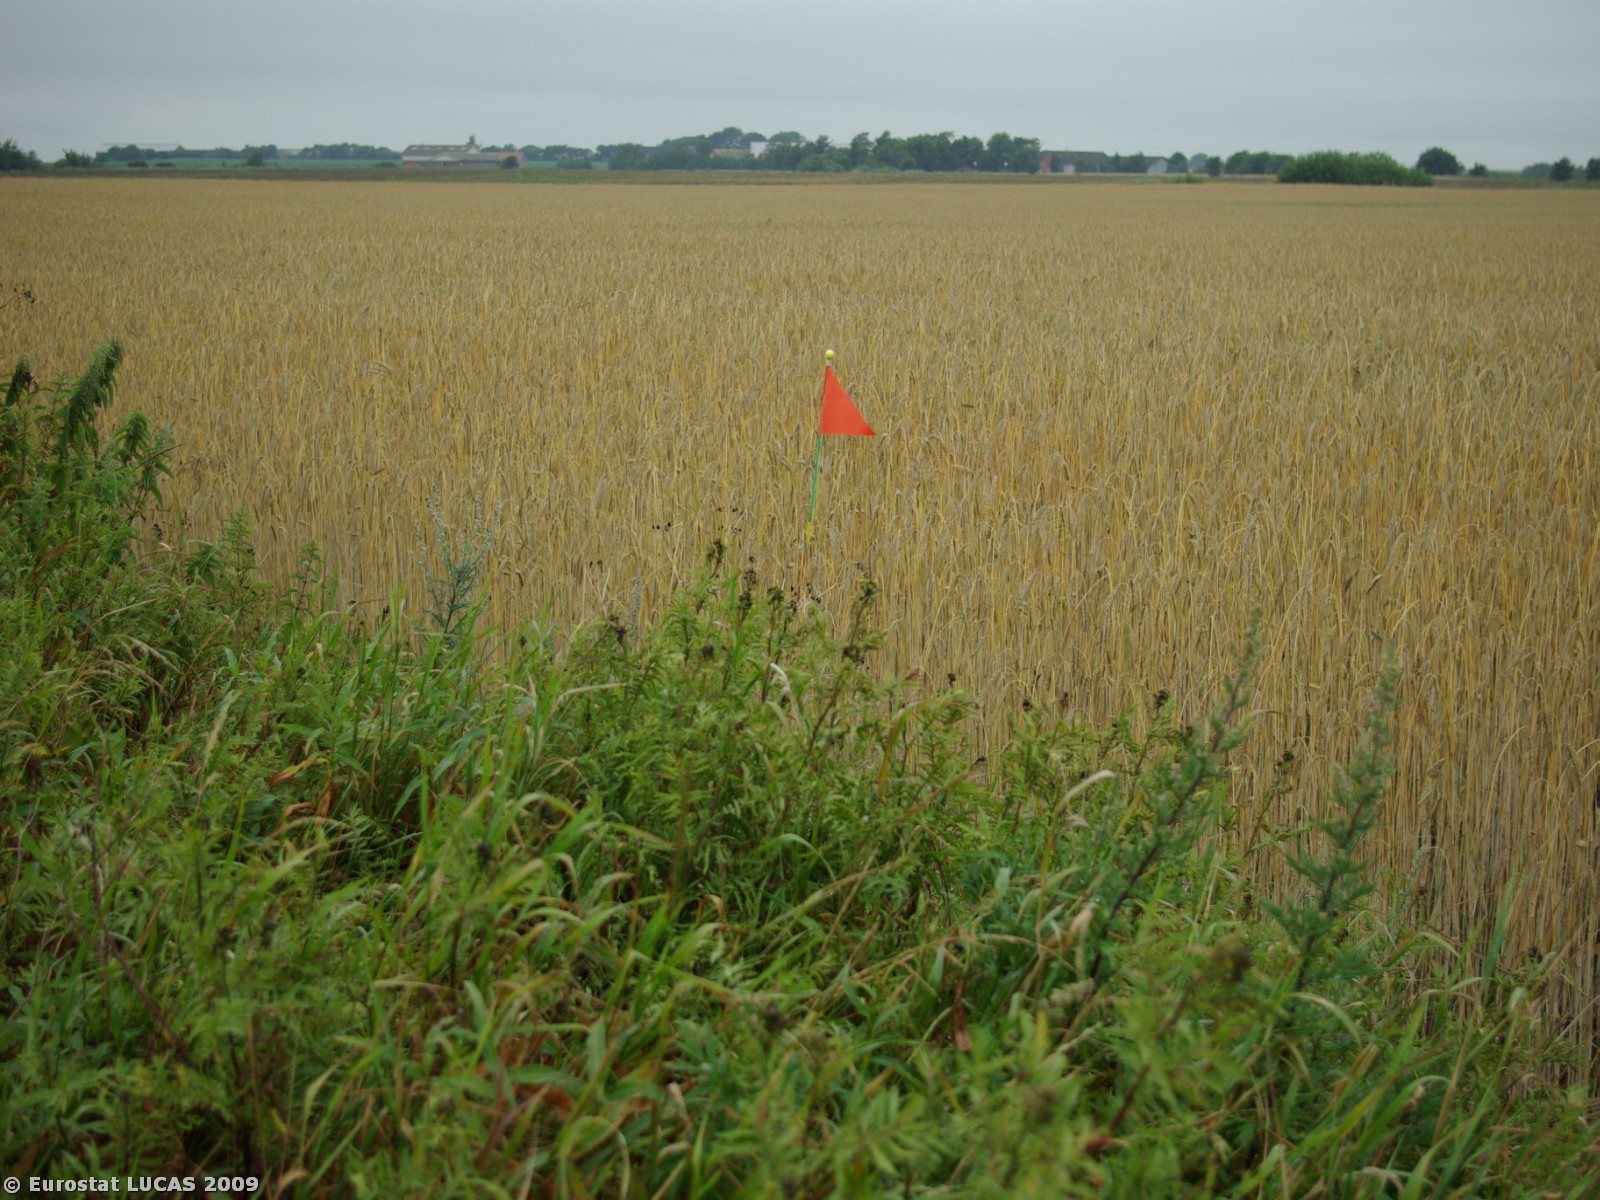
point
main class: Cropland
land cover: Rye
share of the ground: > 75 %
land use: Agriculture (excluding fallow land and kitchen gardens)
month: July
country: DK
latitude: 55.0669
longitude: 8.7326
